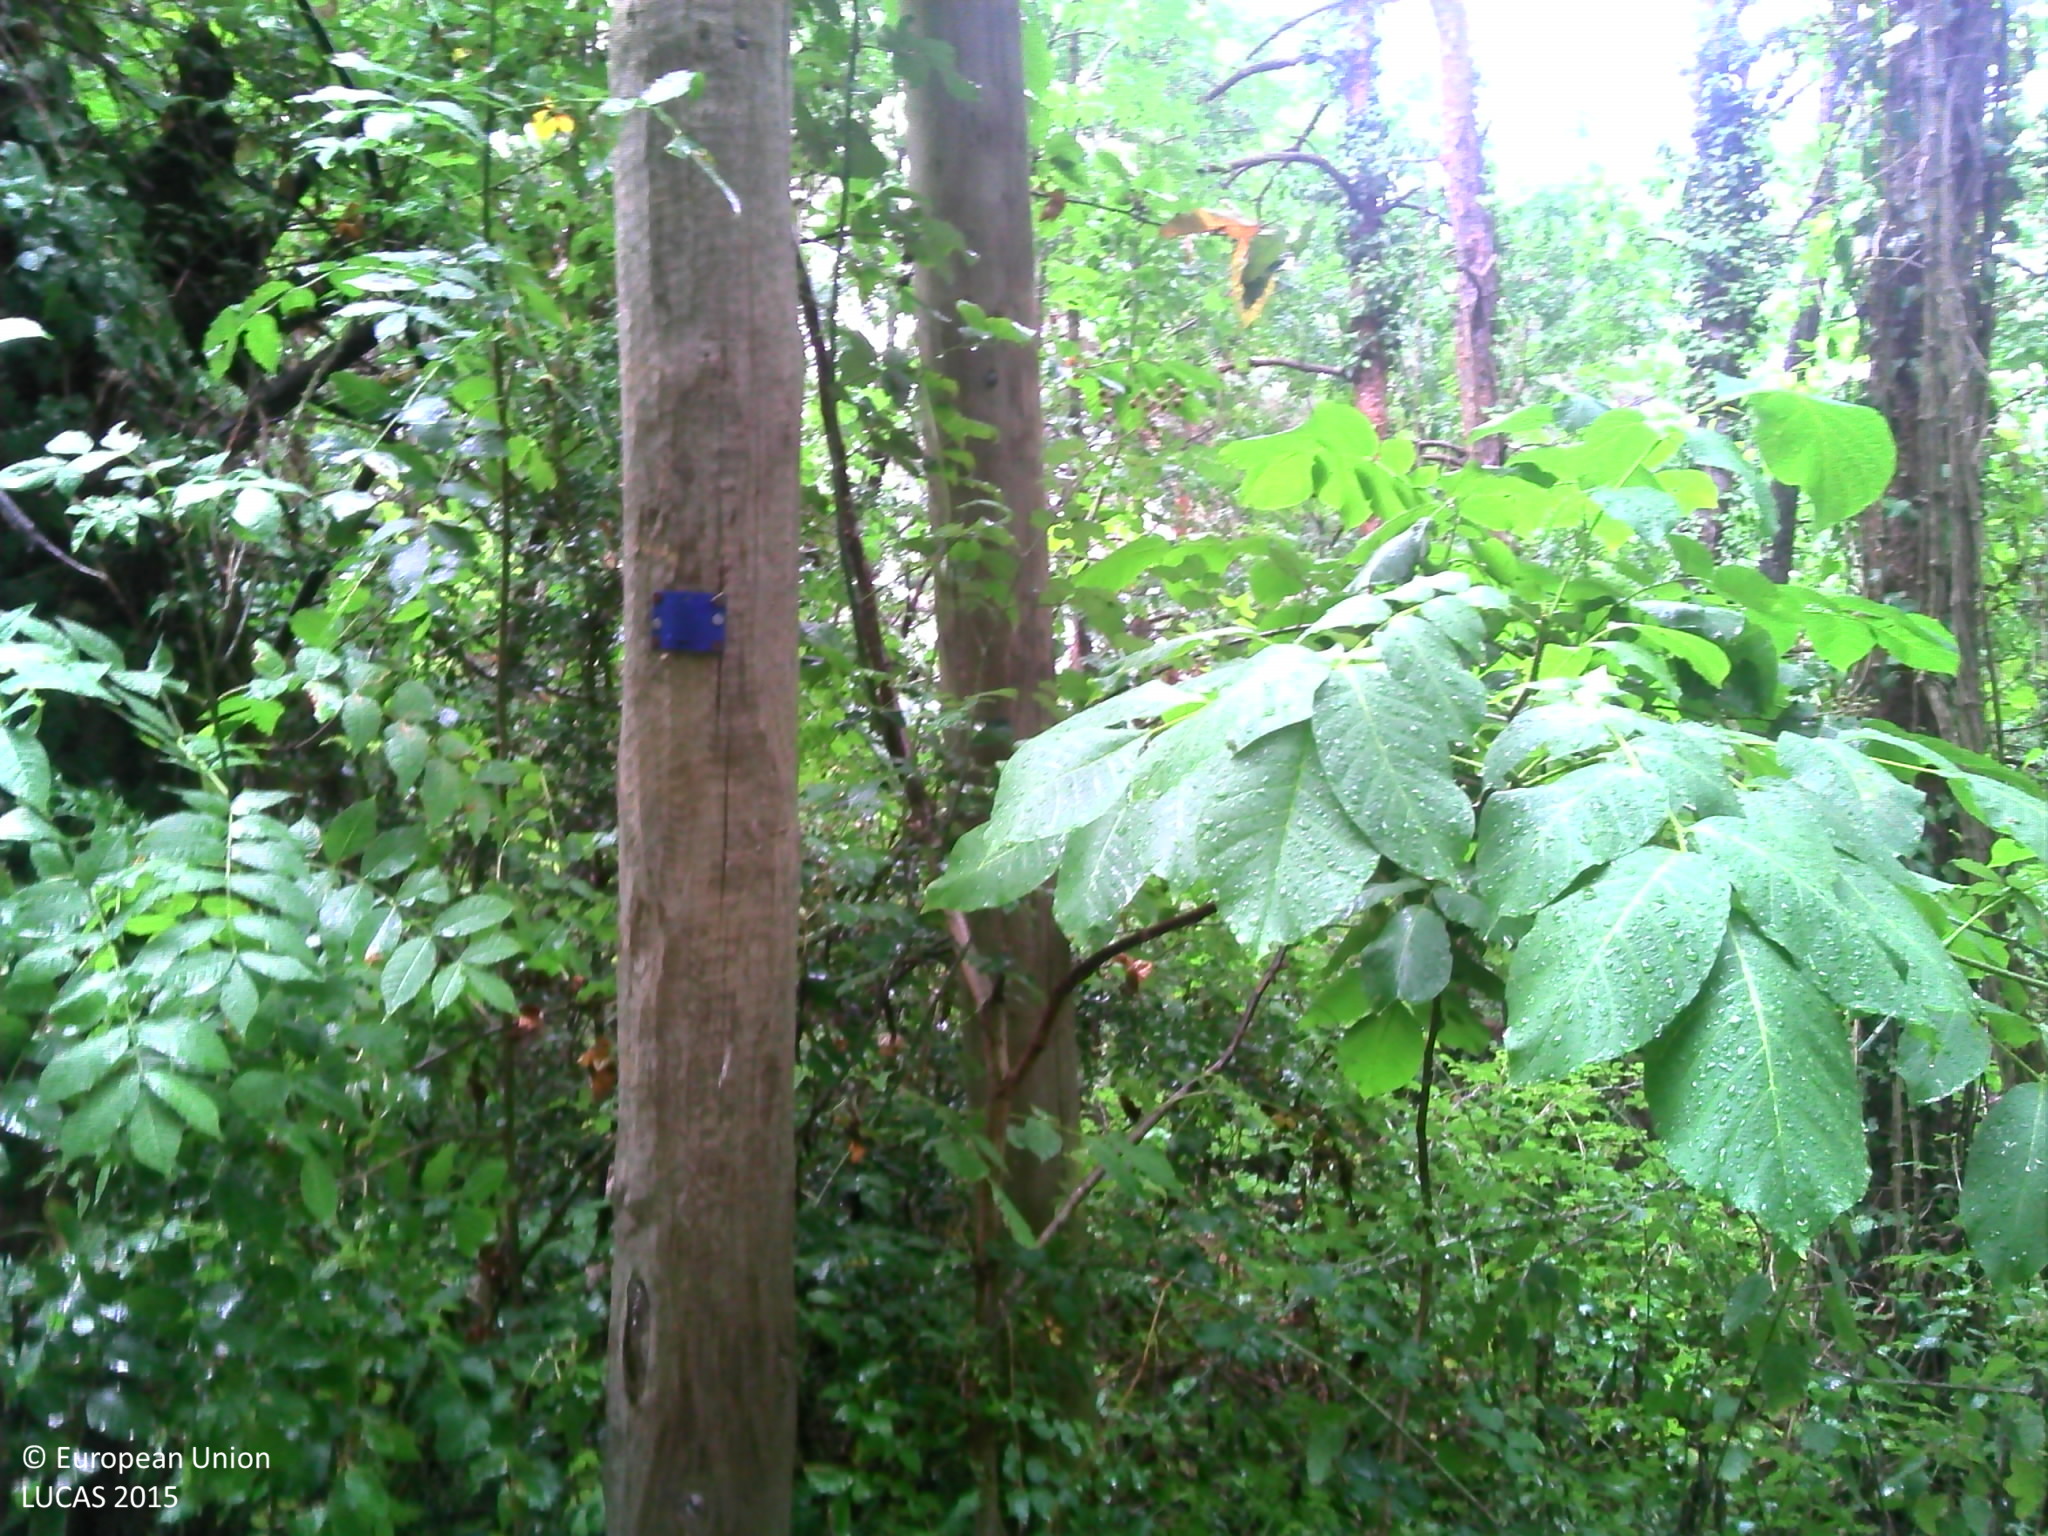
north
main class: Woodland
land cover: Pine dominated mixed woodland
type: mountainous beech forest
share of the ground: > 75 %
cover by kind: broadleaved forest trees 50 %, coniferous forest trees 25 %, herbaceous plants 25 %
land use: Semi-natural and natural areas not in use
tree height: > 5 m
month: July
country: FR
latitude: 44.7887
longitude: 4.6089
